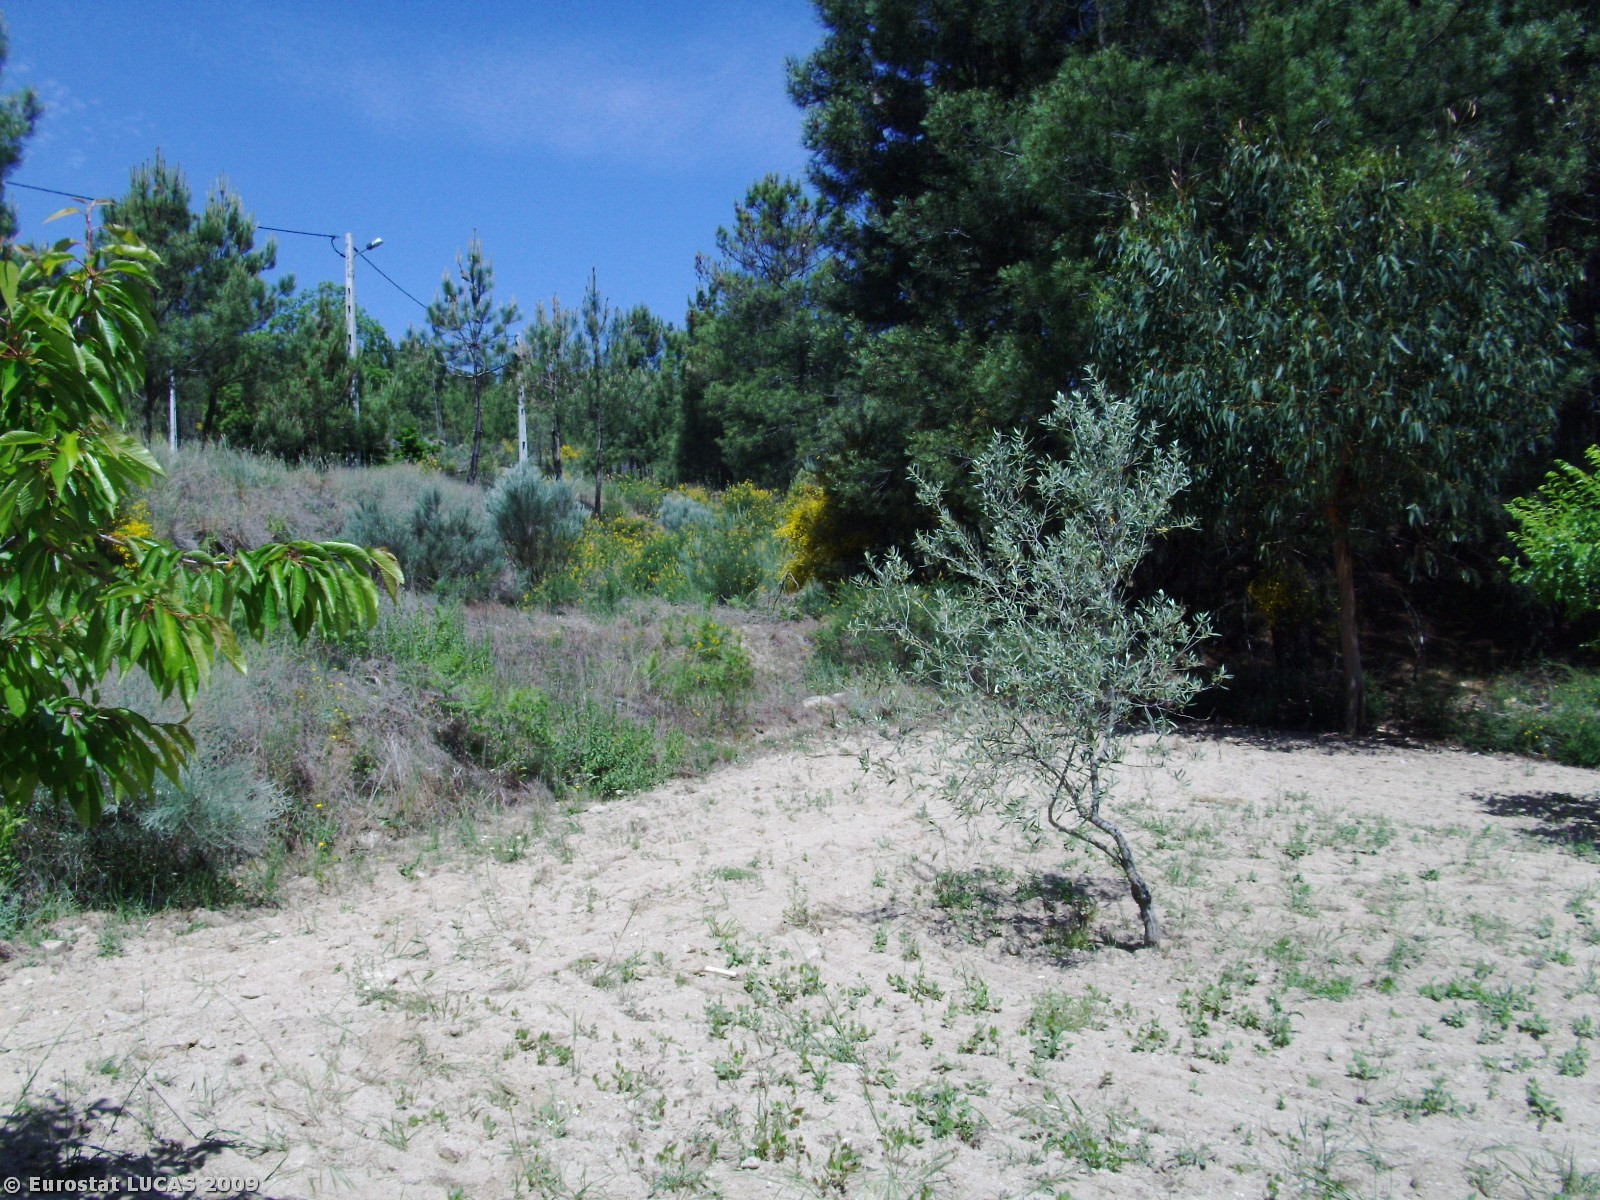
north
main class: Cropland
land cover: Olive groves
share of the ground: 50 - 75 %
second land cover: Cherry fruit
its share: 25 - 50 %
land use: Agriculture (excluding fallow land and kitchen gardens)
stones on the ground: 25 - 50 %
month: May
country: PT
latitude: 40.8176
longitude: -7.3145
